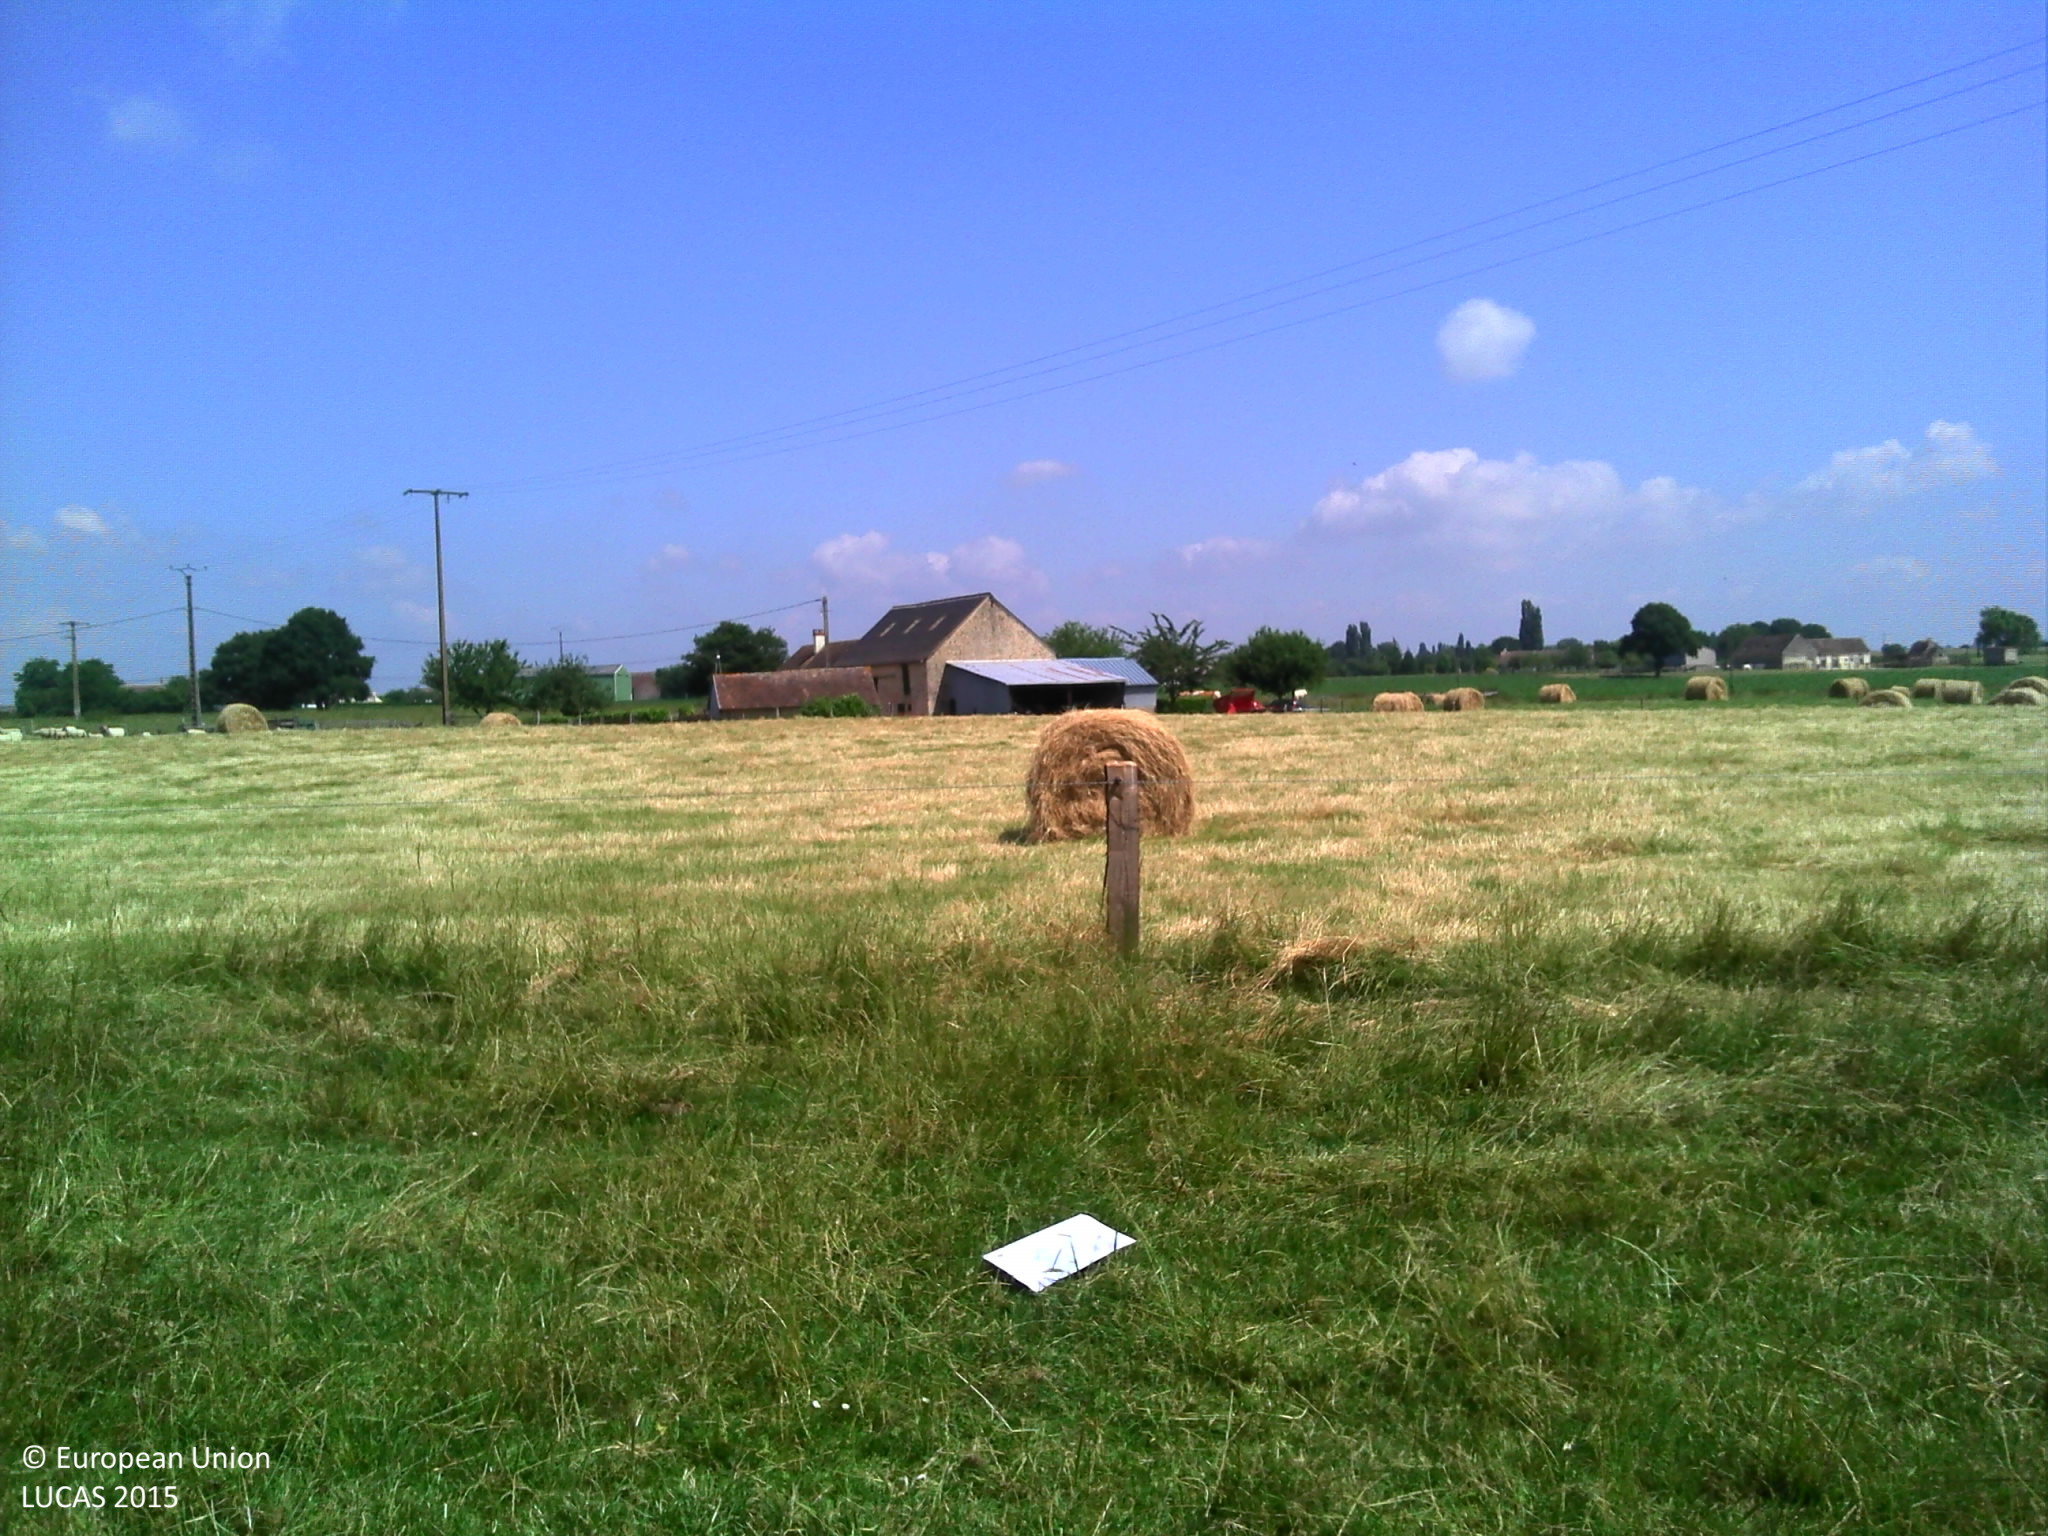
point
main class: Grassland
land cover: Grassland without tree/shrub cover
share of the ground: > 75 %
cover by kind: herbaceous plants 100 %
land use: Agriculture (excluding fallow land and kitchen gardens)
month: June
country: FR
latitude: 48.2448
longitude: 0.2646
